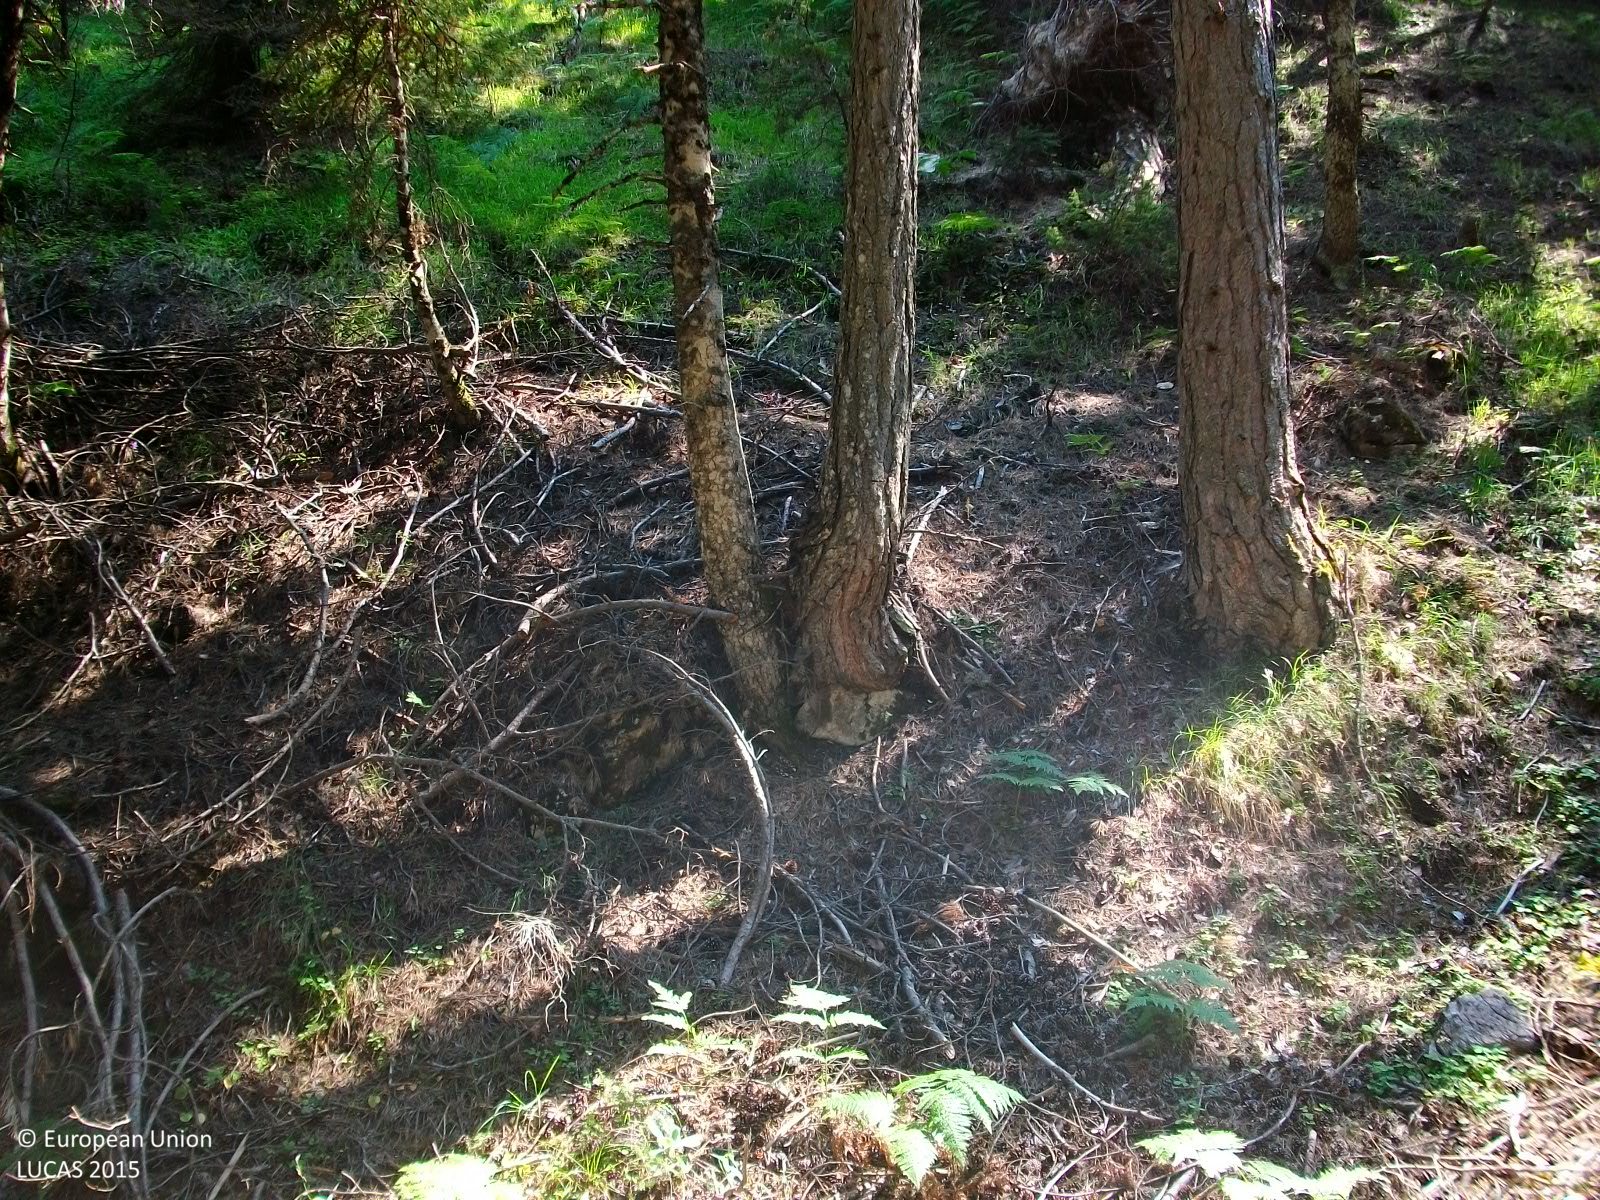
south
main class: Woodland
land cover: Spruce dominated mixed woodland
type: coniferous forest of the mediterranean region
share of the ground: > 75 %
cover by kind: coniferous forest trees 65 %, broadleaved forest trees 25 %, herbaceous plants 10 %
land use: Forestry
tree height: > 5 m
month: July
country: GR
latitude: 38.5949
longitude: 22.5731
